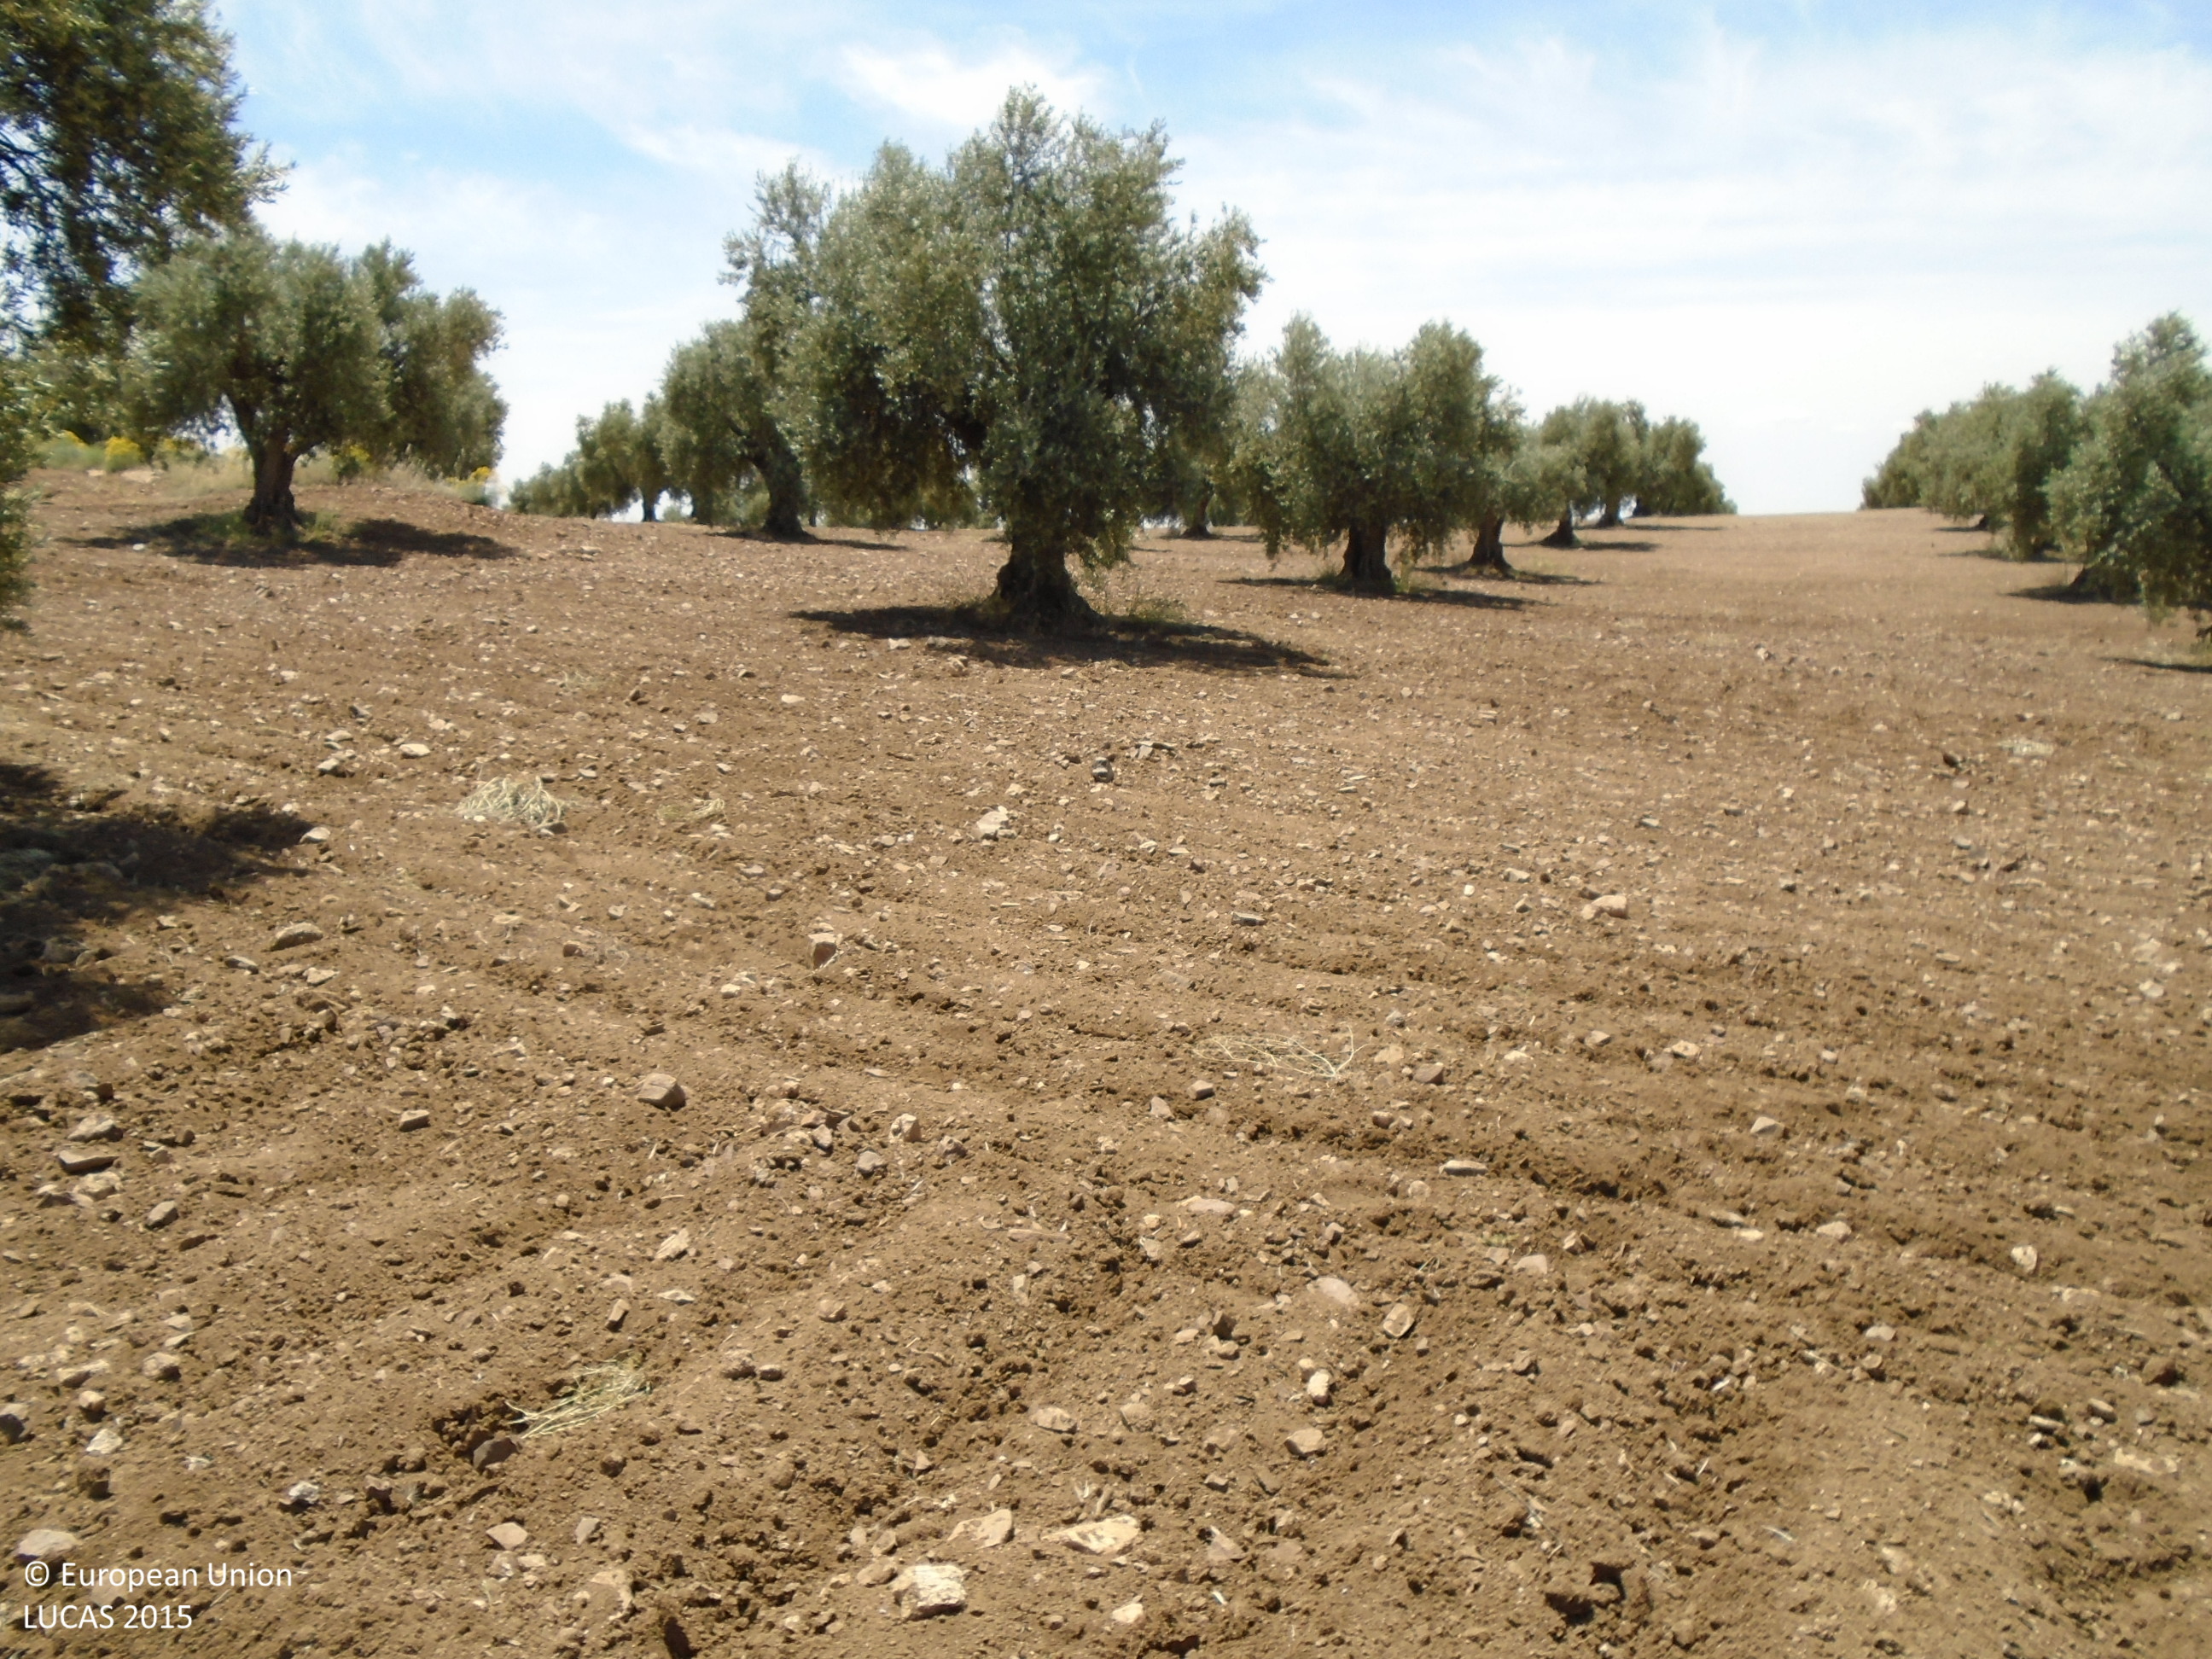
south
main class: Cropland
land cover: Olive groves
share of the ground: 10 - 25 %
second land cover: Other bare soil
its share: > 75 %
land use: Agriculture (excluding fallow land and kitchen gardens)
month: May
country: ES
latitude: 39.7822
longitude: -3.7966
